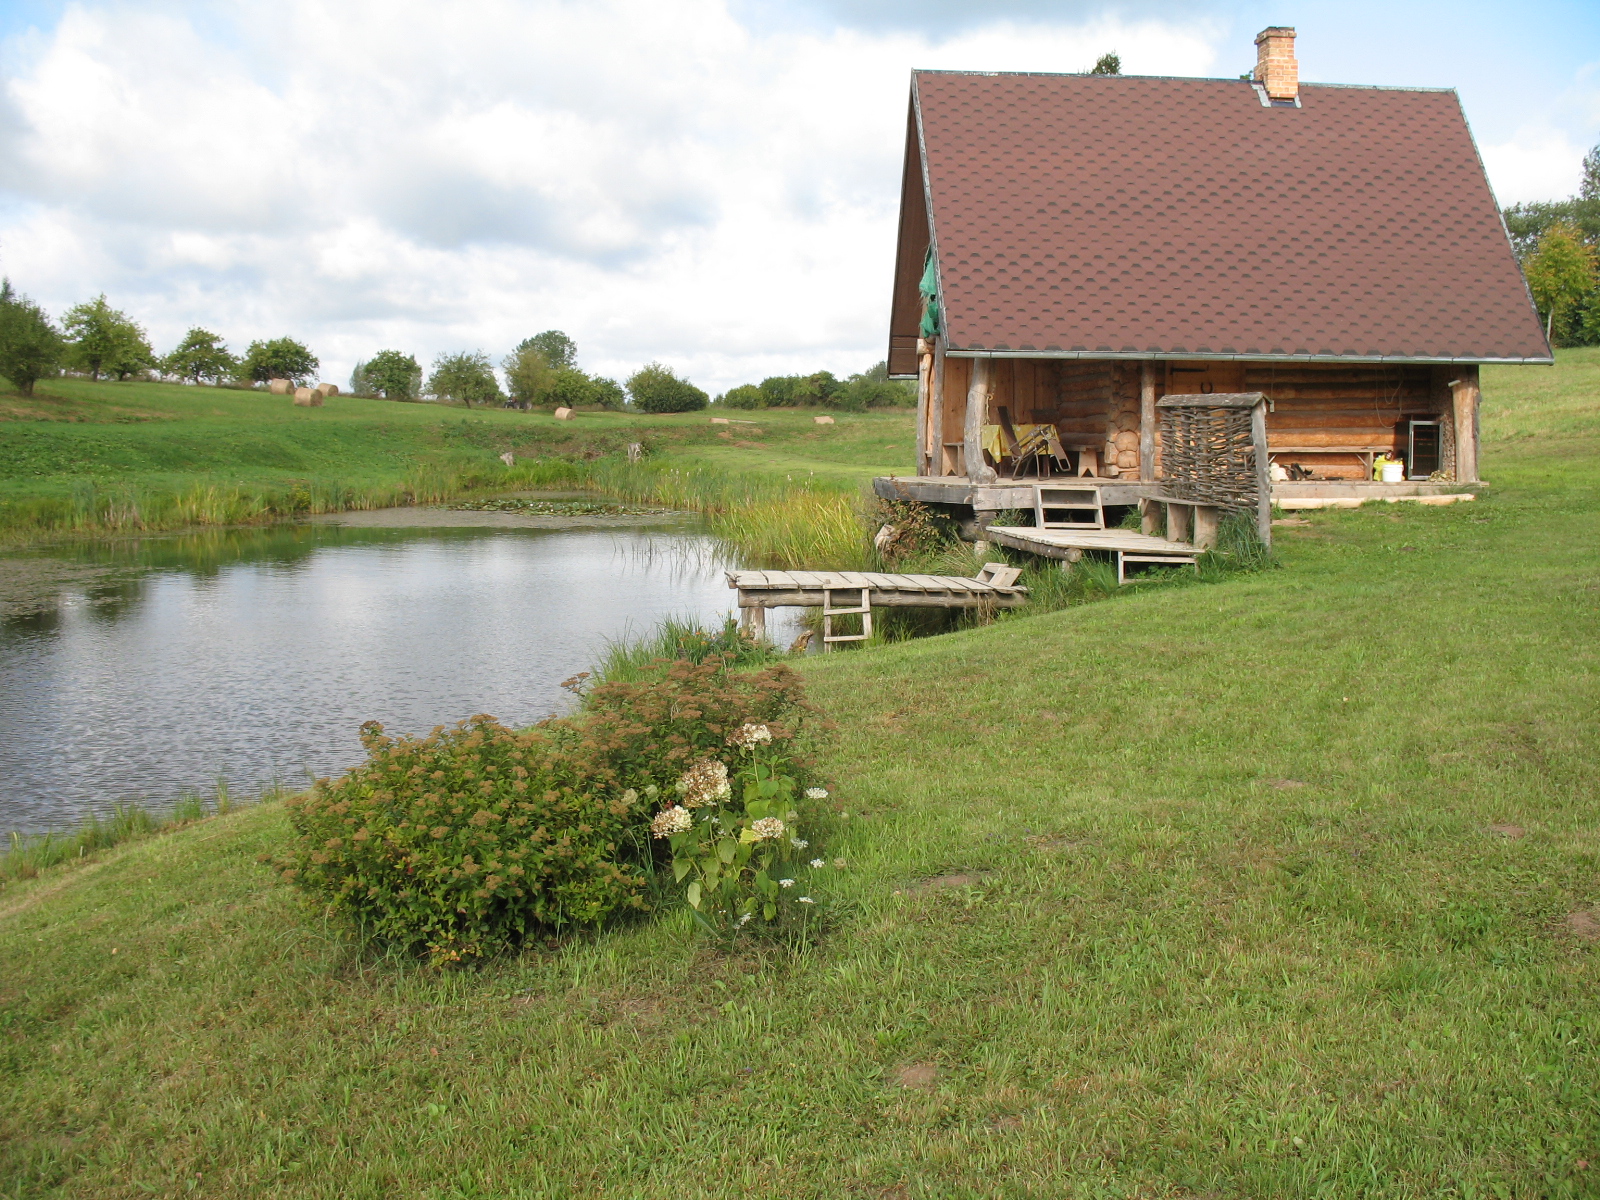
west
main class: Grassland
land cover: Grassland without tree/shrub cover
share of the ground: > 75 %
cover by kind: herbaceous plants 100 %
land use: Residential
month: August
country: LV
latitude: 56.2753
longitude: 26.0102
